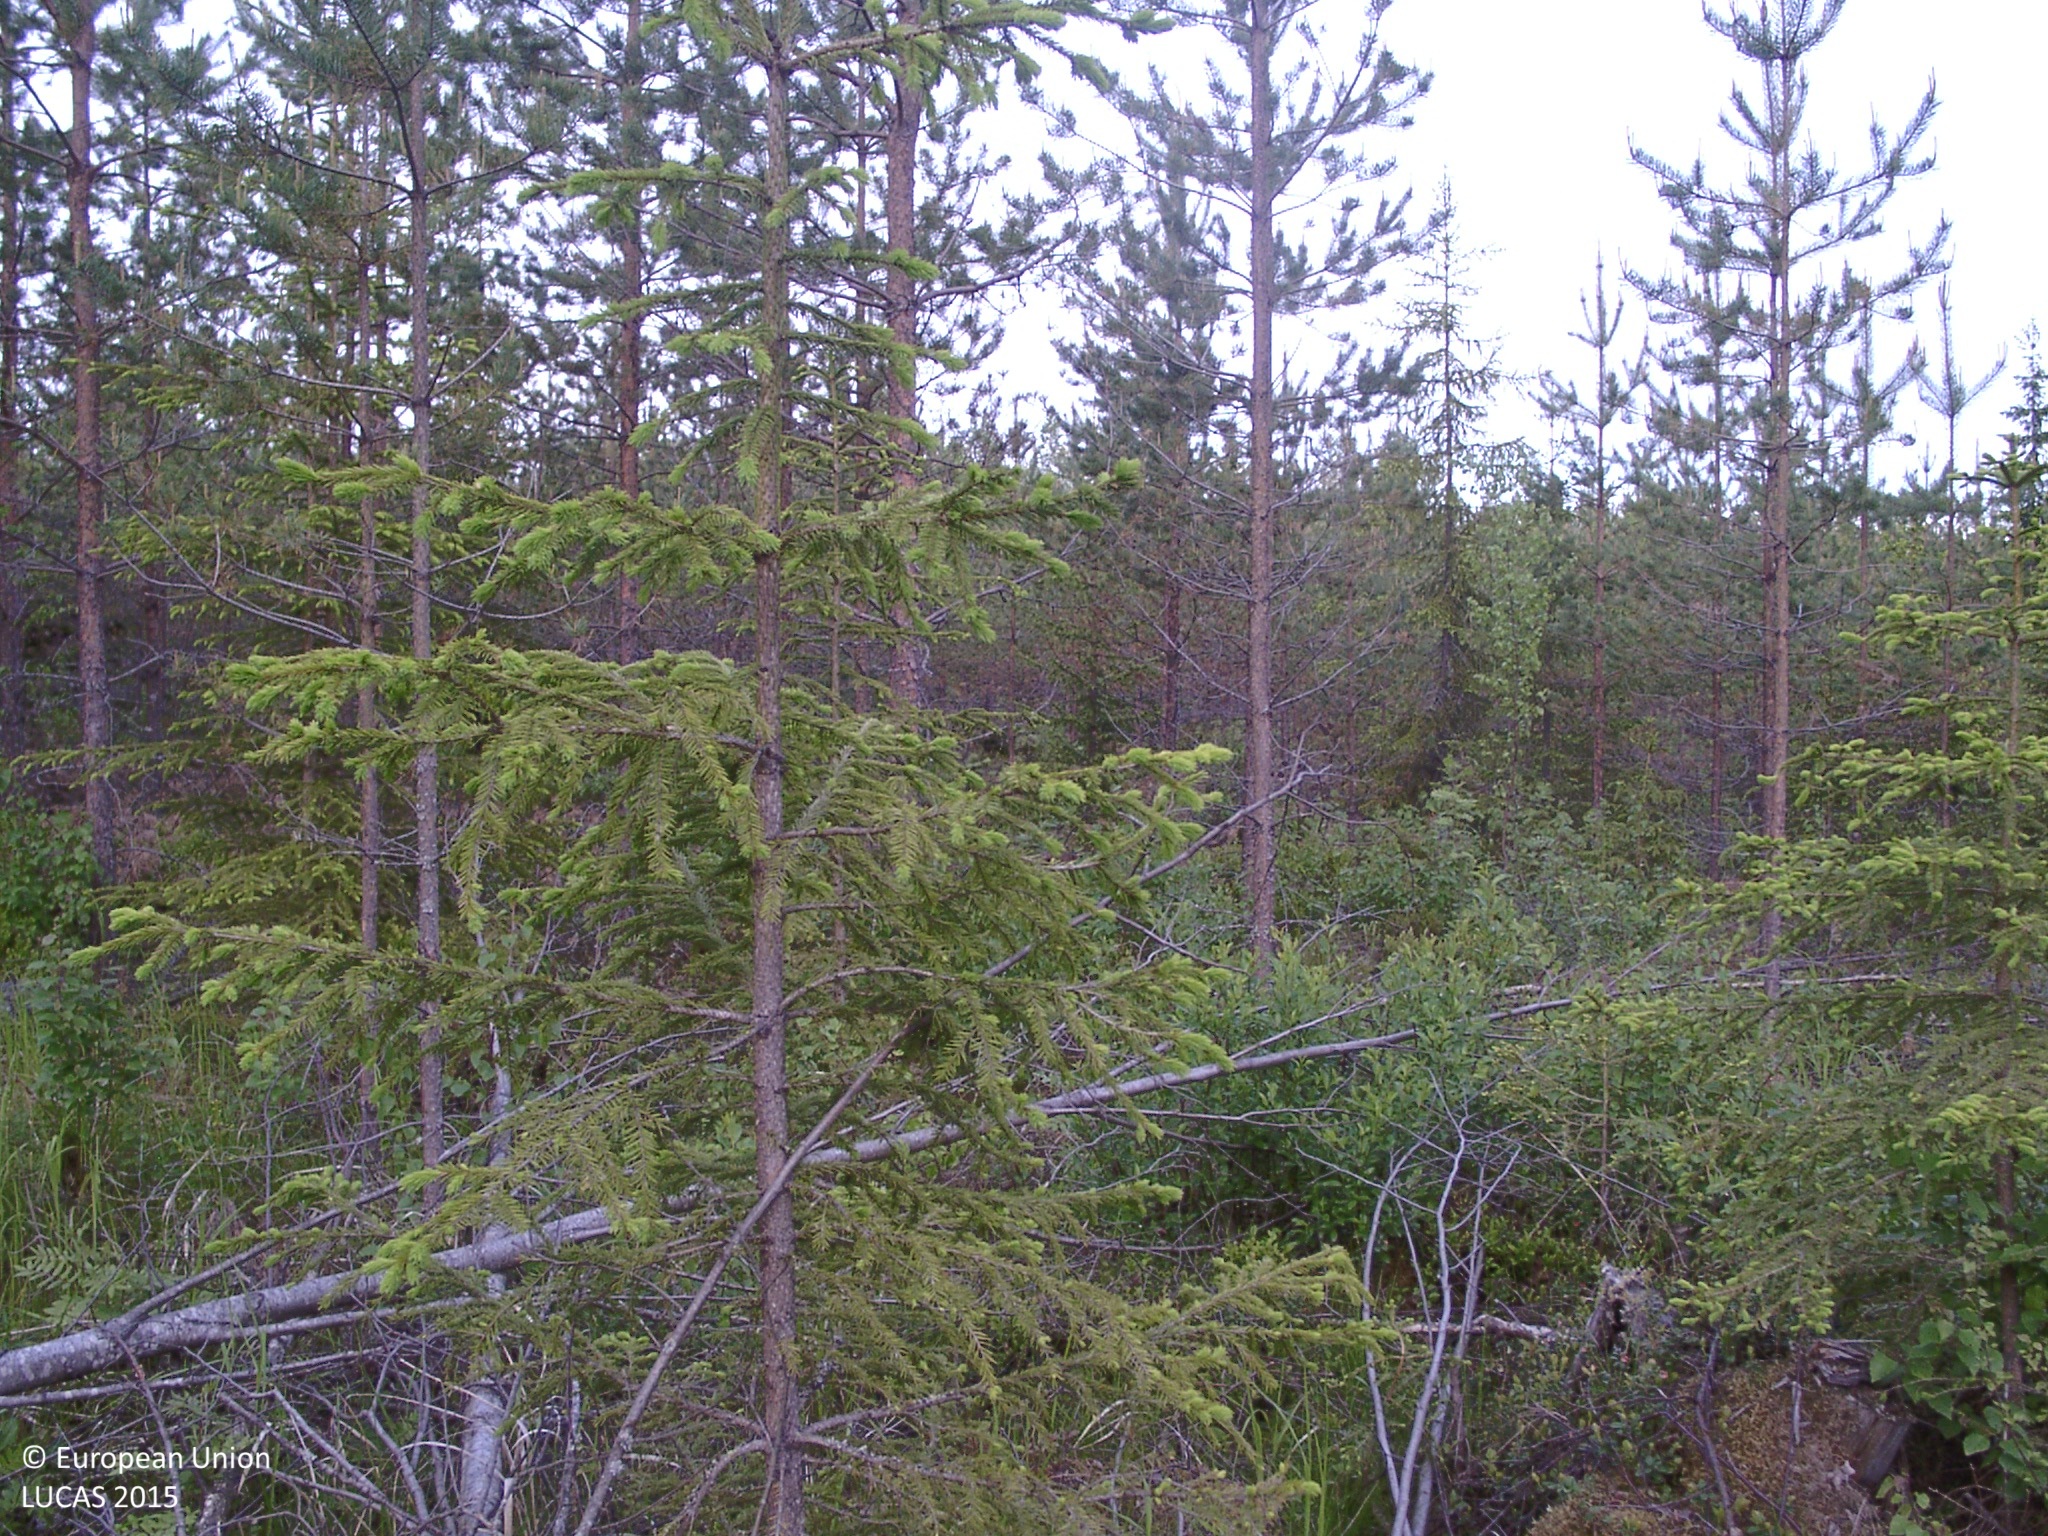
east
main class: Woodland
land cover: Spruce dominated mixed woodland
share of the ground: 50 - 75 %
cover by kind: broadleaved forest trees 40 %, coniferous forest trees 25 %, herbaceous plants 20 %, shrubs 5 %
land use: Forestry
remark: Nursery
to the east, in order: Spruce dominated mixed woodland; Pine dominated coniferous woodland; Shrubland without tree cover; Spruce dominated coniferous woodland; Other mixed woodland; Groves; Ditches and canals; Spruce dominated coniferous woodland
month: June
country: FI
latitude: 62.1721
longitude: 26.0078
